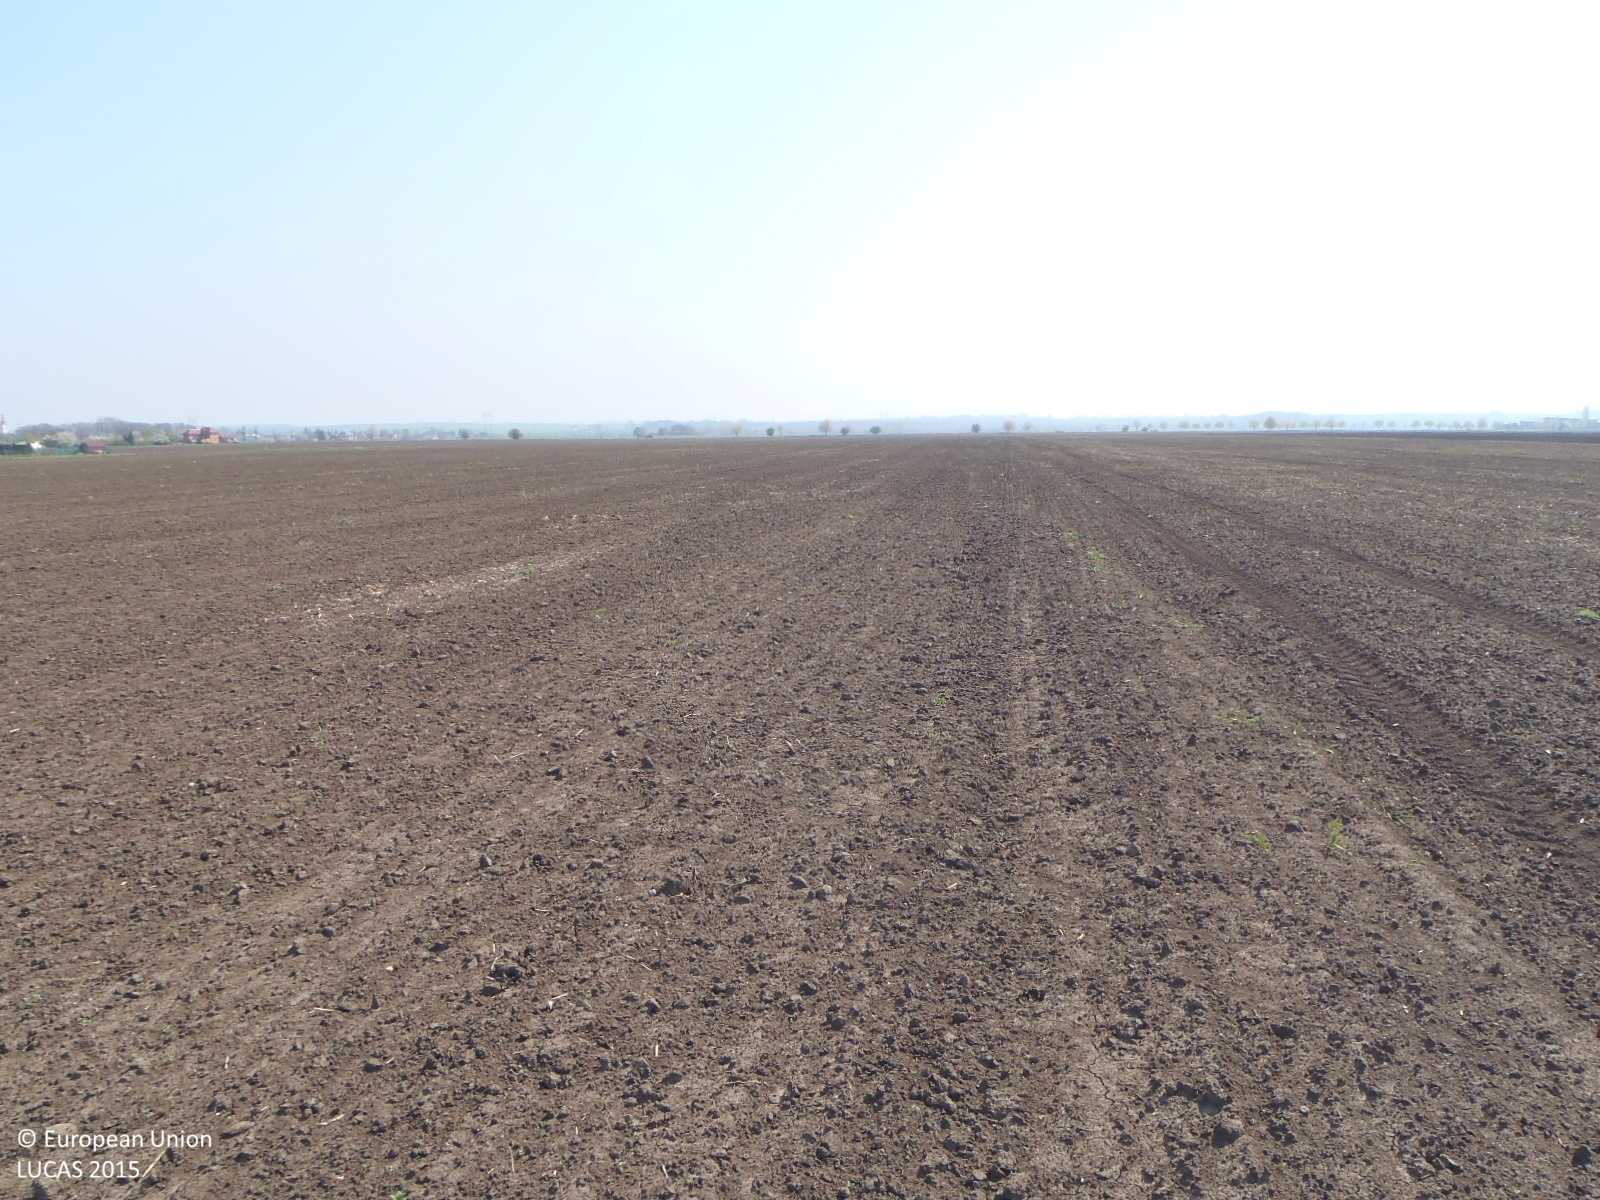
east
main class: Cropland
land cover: Other fibre and oleaginous crops
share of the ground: < 10 %
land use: Agriculture (excluding fallow land and kitchen gardens)
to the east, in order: Other fibre and oleaginous crops
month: April
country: CZ
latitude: 49.5833
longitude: 17.1056
